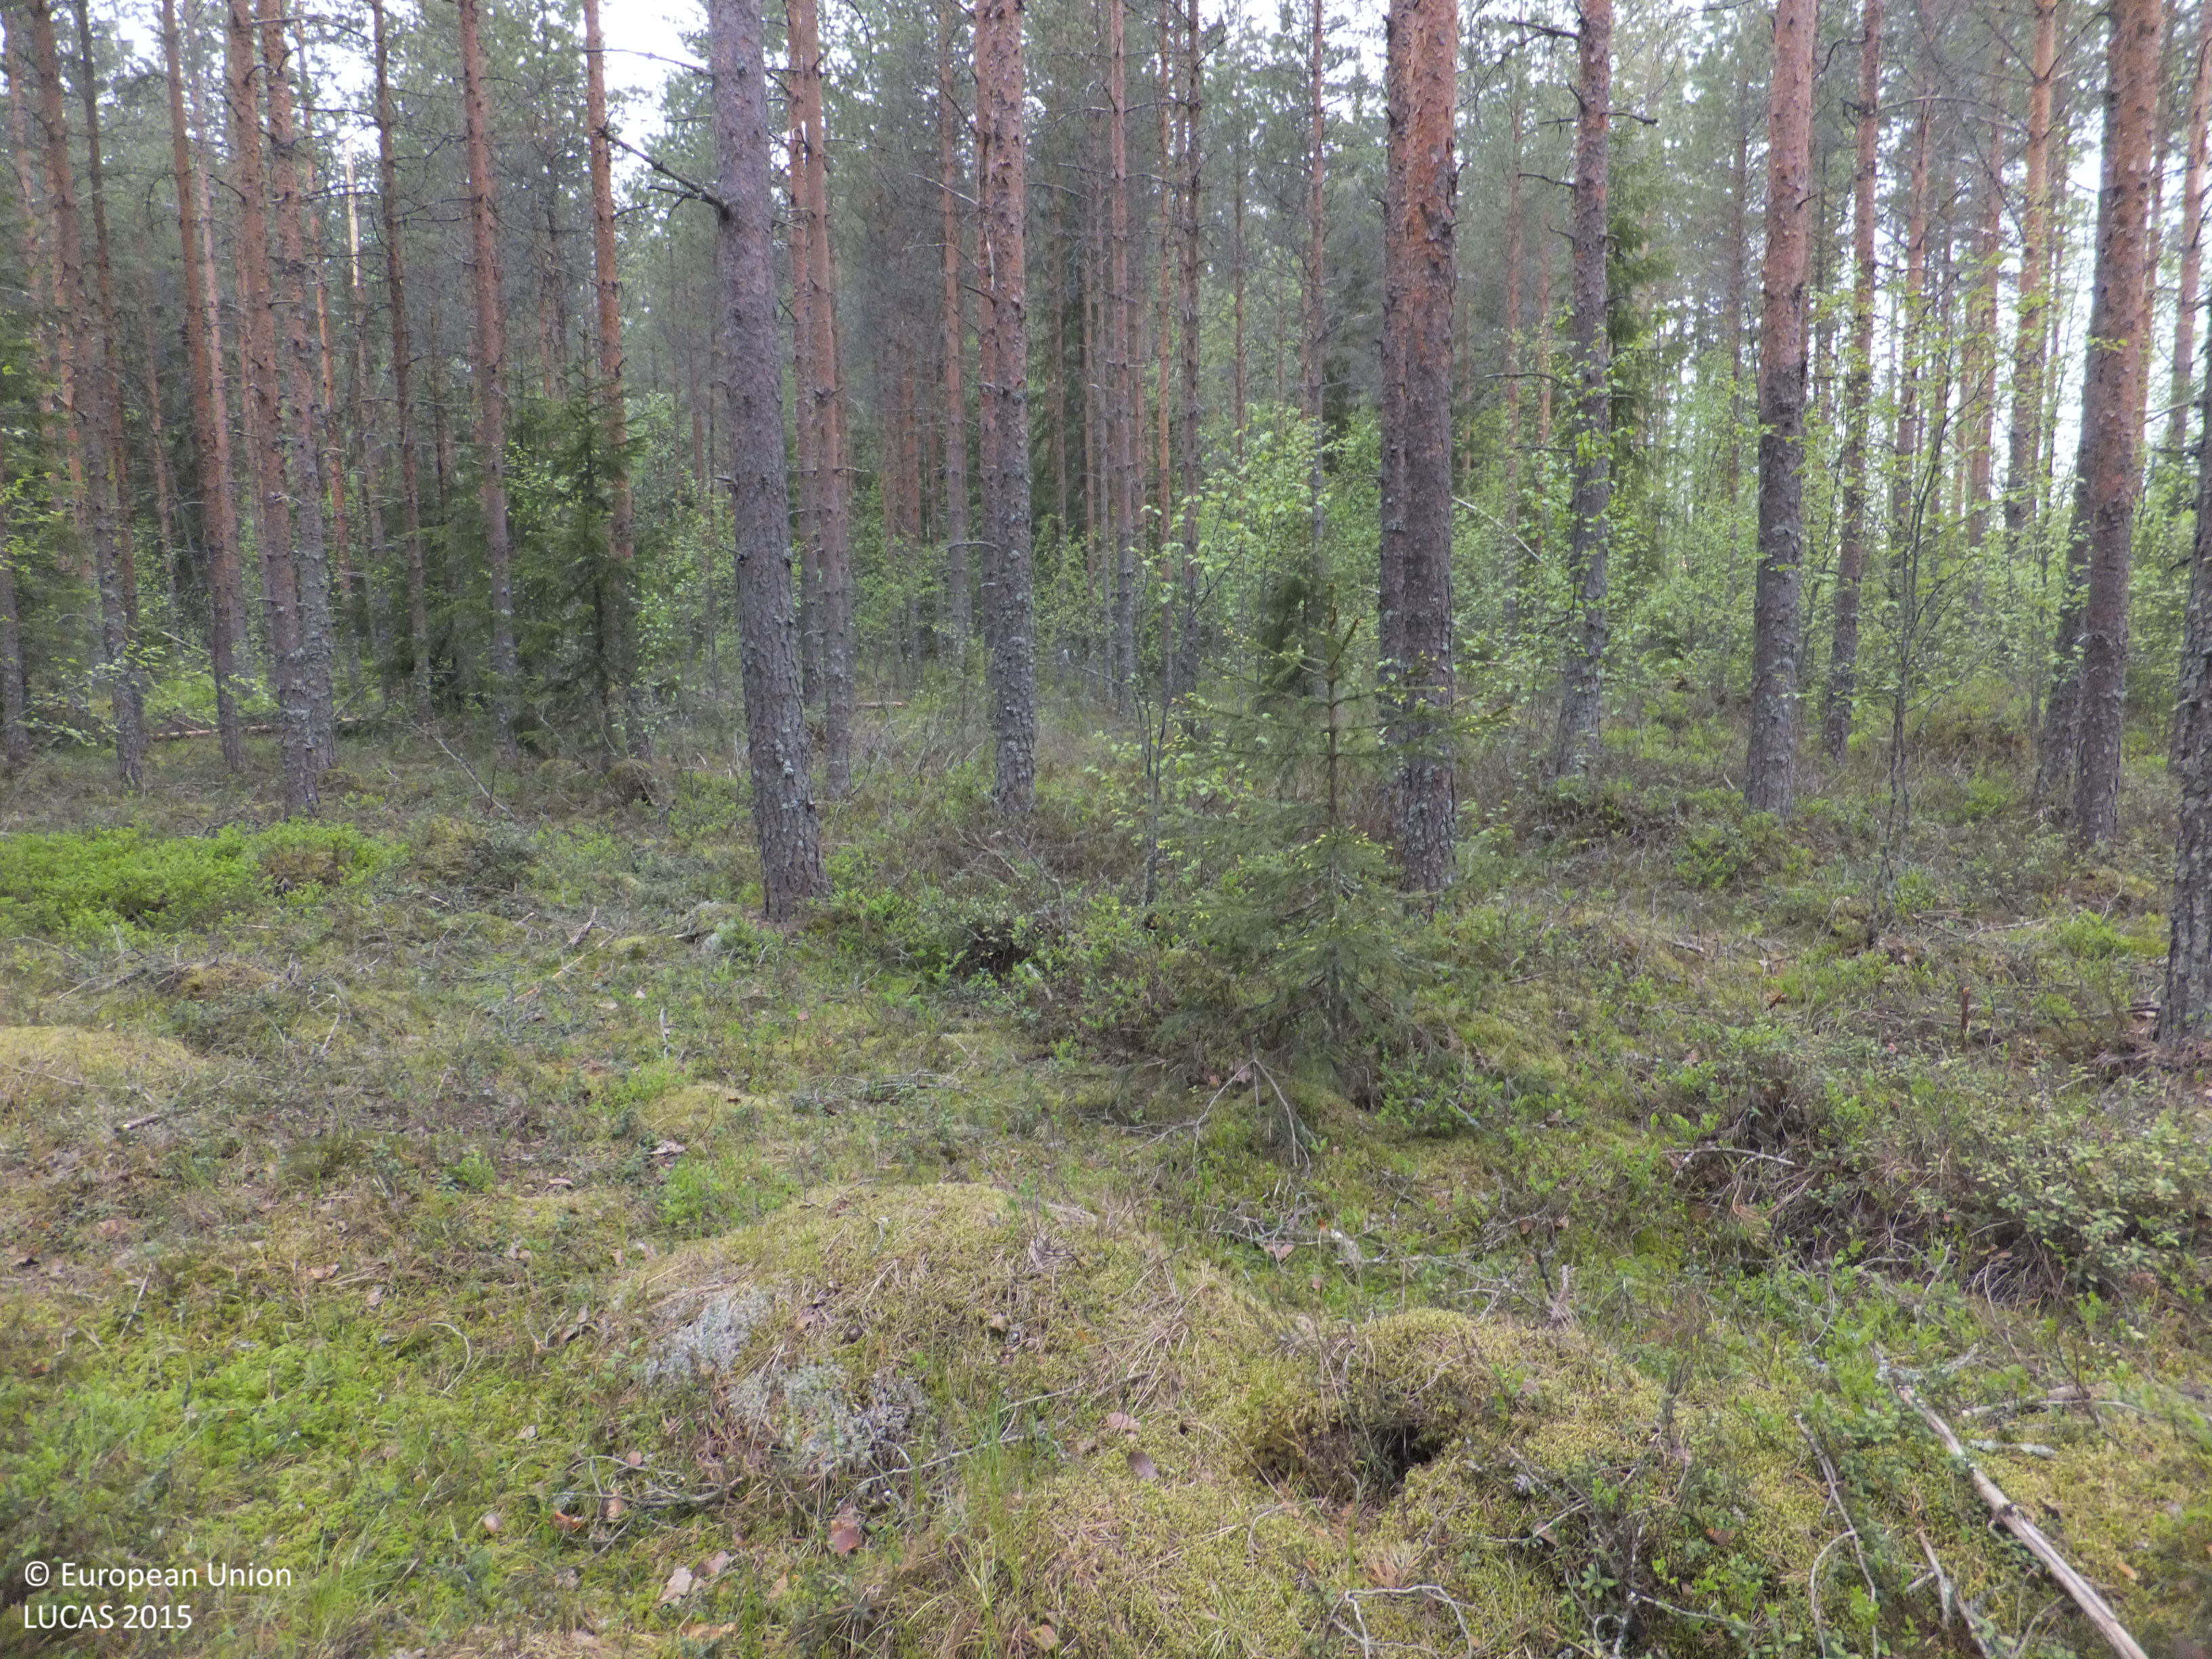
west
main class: Woodland
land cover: Pine dominated coniferous woodland
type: hemiboreal forest and nemoral coniferous forest and mixed broadleaved-coniferous forest
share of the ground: > 75 %
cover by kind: coniferous forest trees 80 %, shrubs 15 %, lichens and mosses 5 %
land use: Forestry
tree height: > 5 m
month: June
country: FI
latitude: 63.4920
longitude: 22.8037
